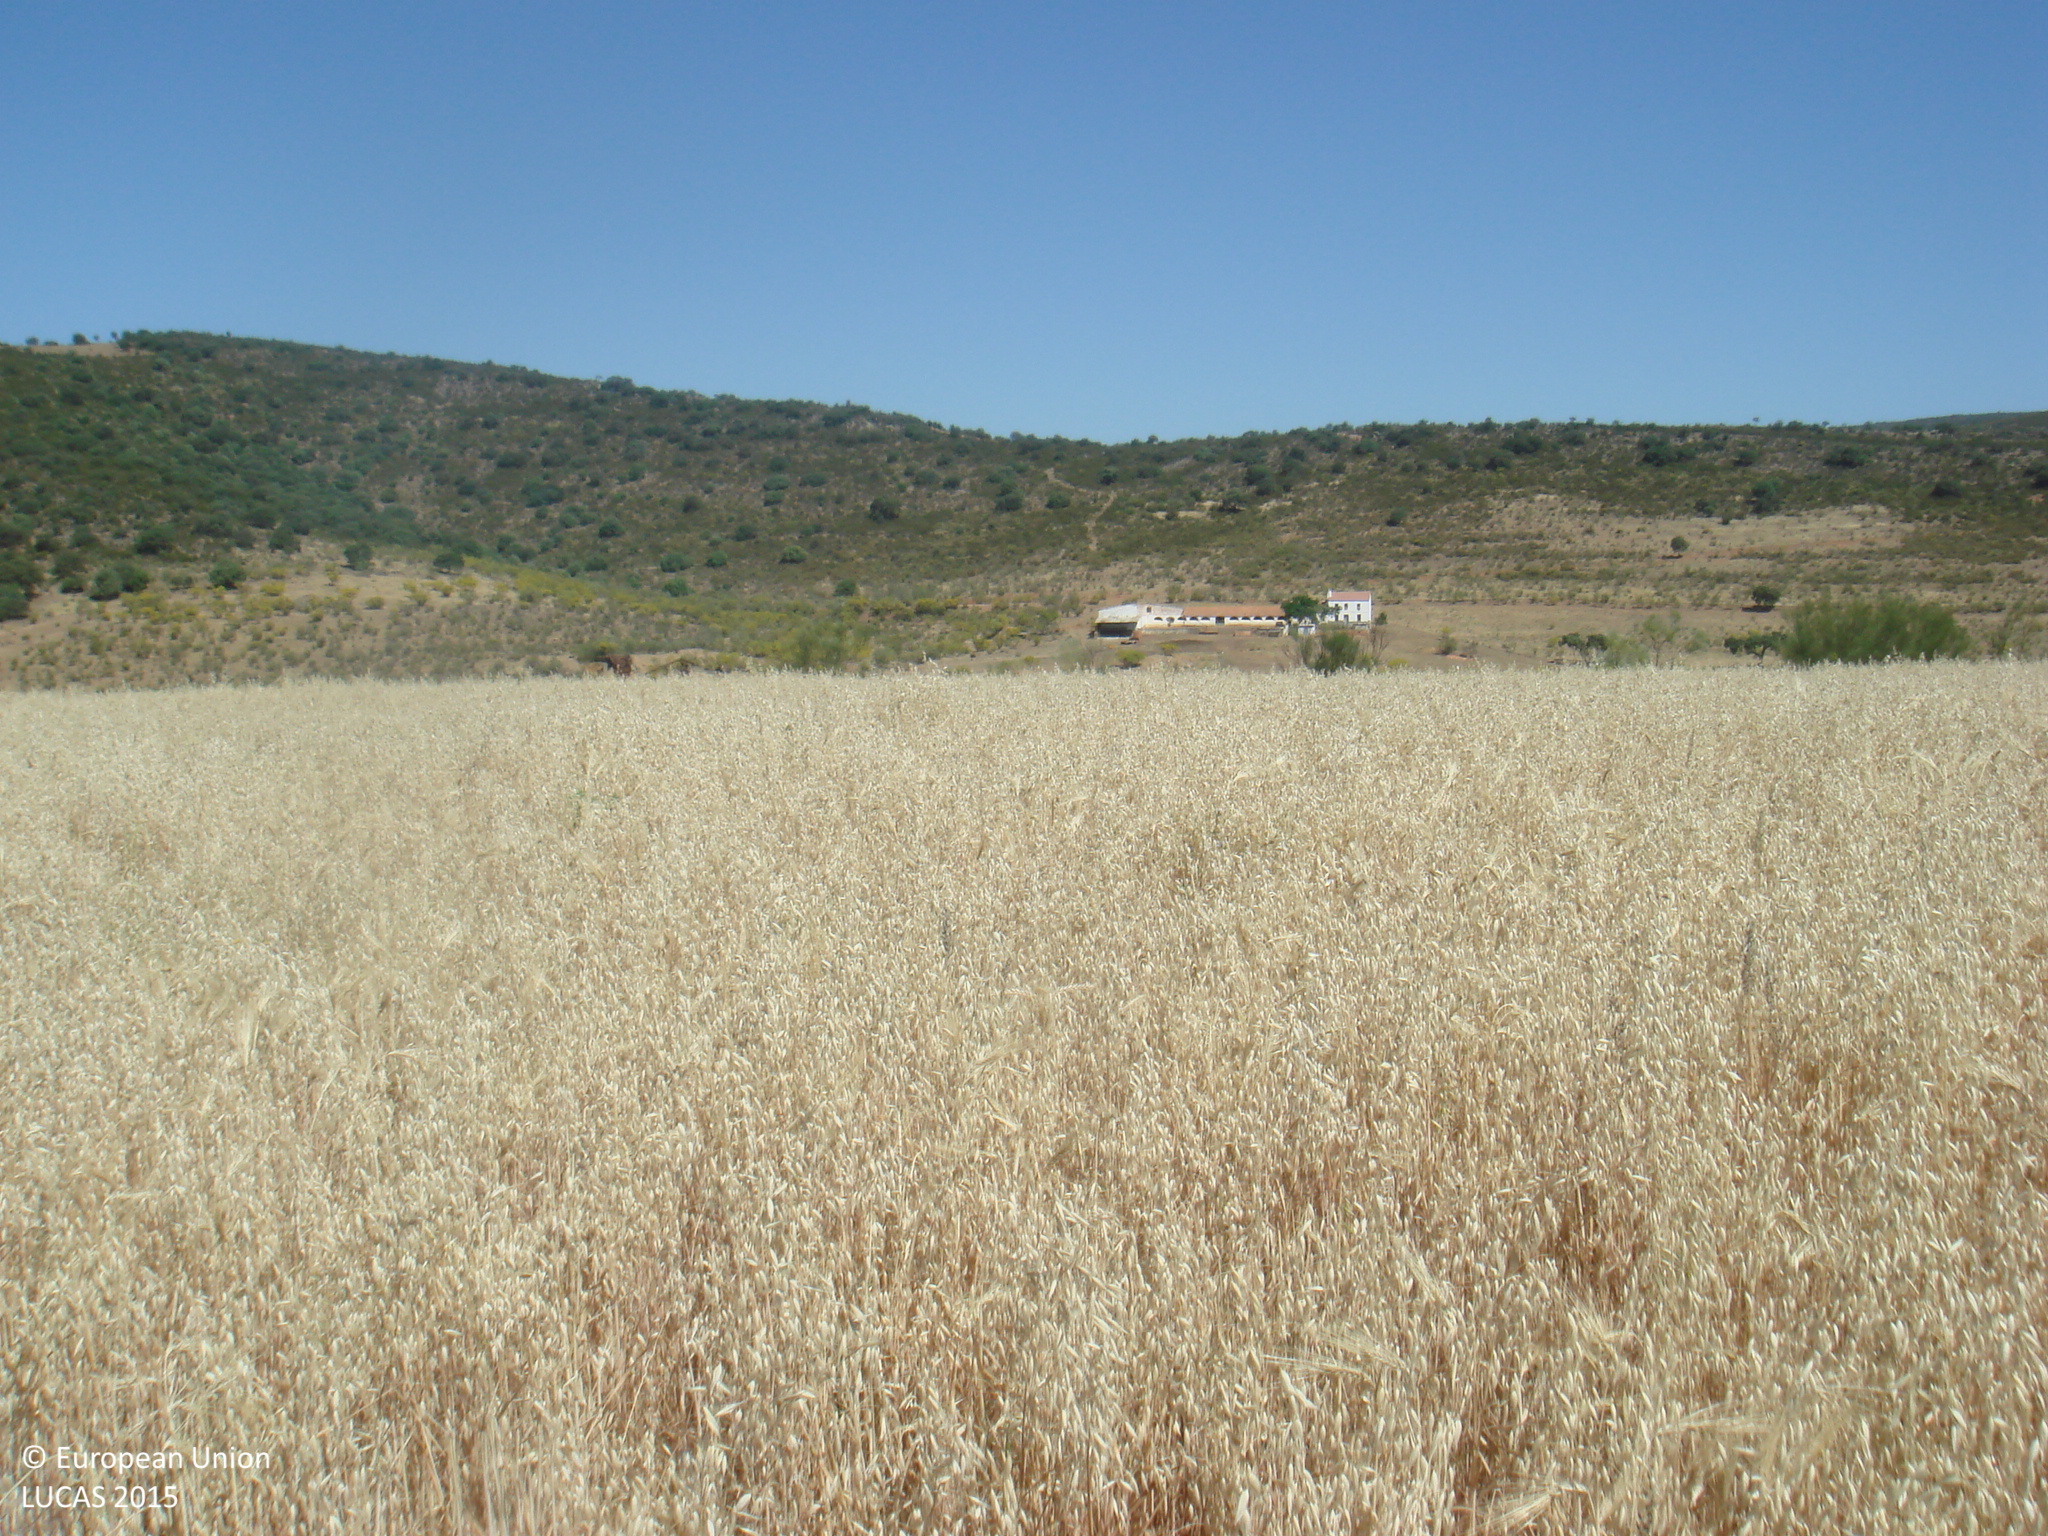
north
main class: Cropland
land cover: Mixed cereals for fodder
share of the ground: > 75 %
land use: Agriculture (excluding fallow land and kitchen gardens)
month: May
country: ES
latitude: 38.6755
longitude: -5.1711
